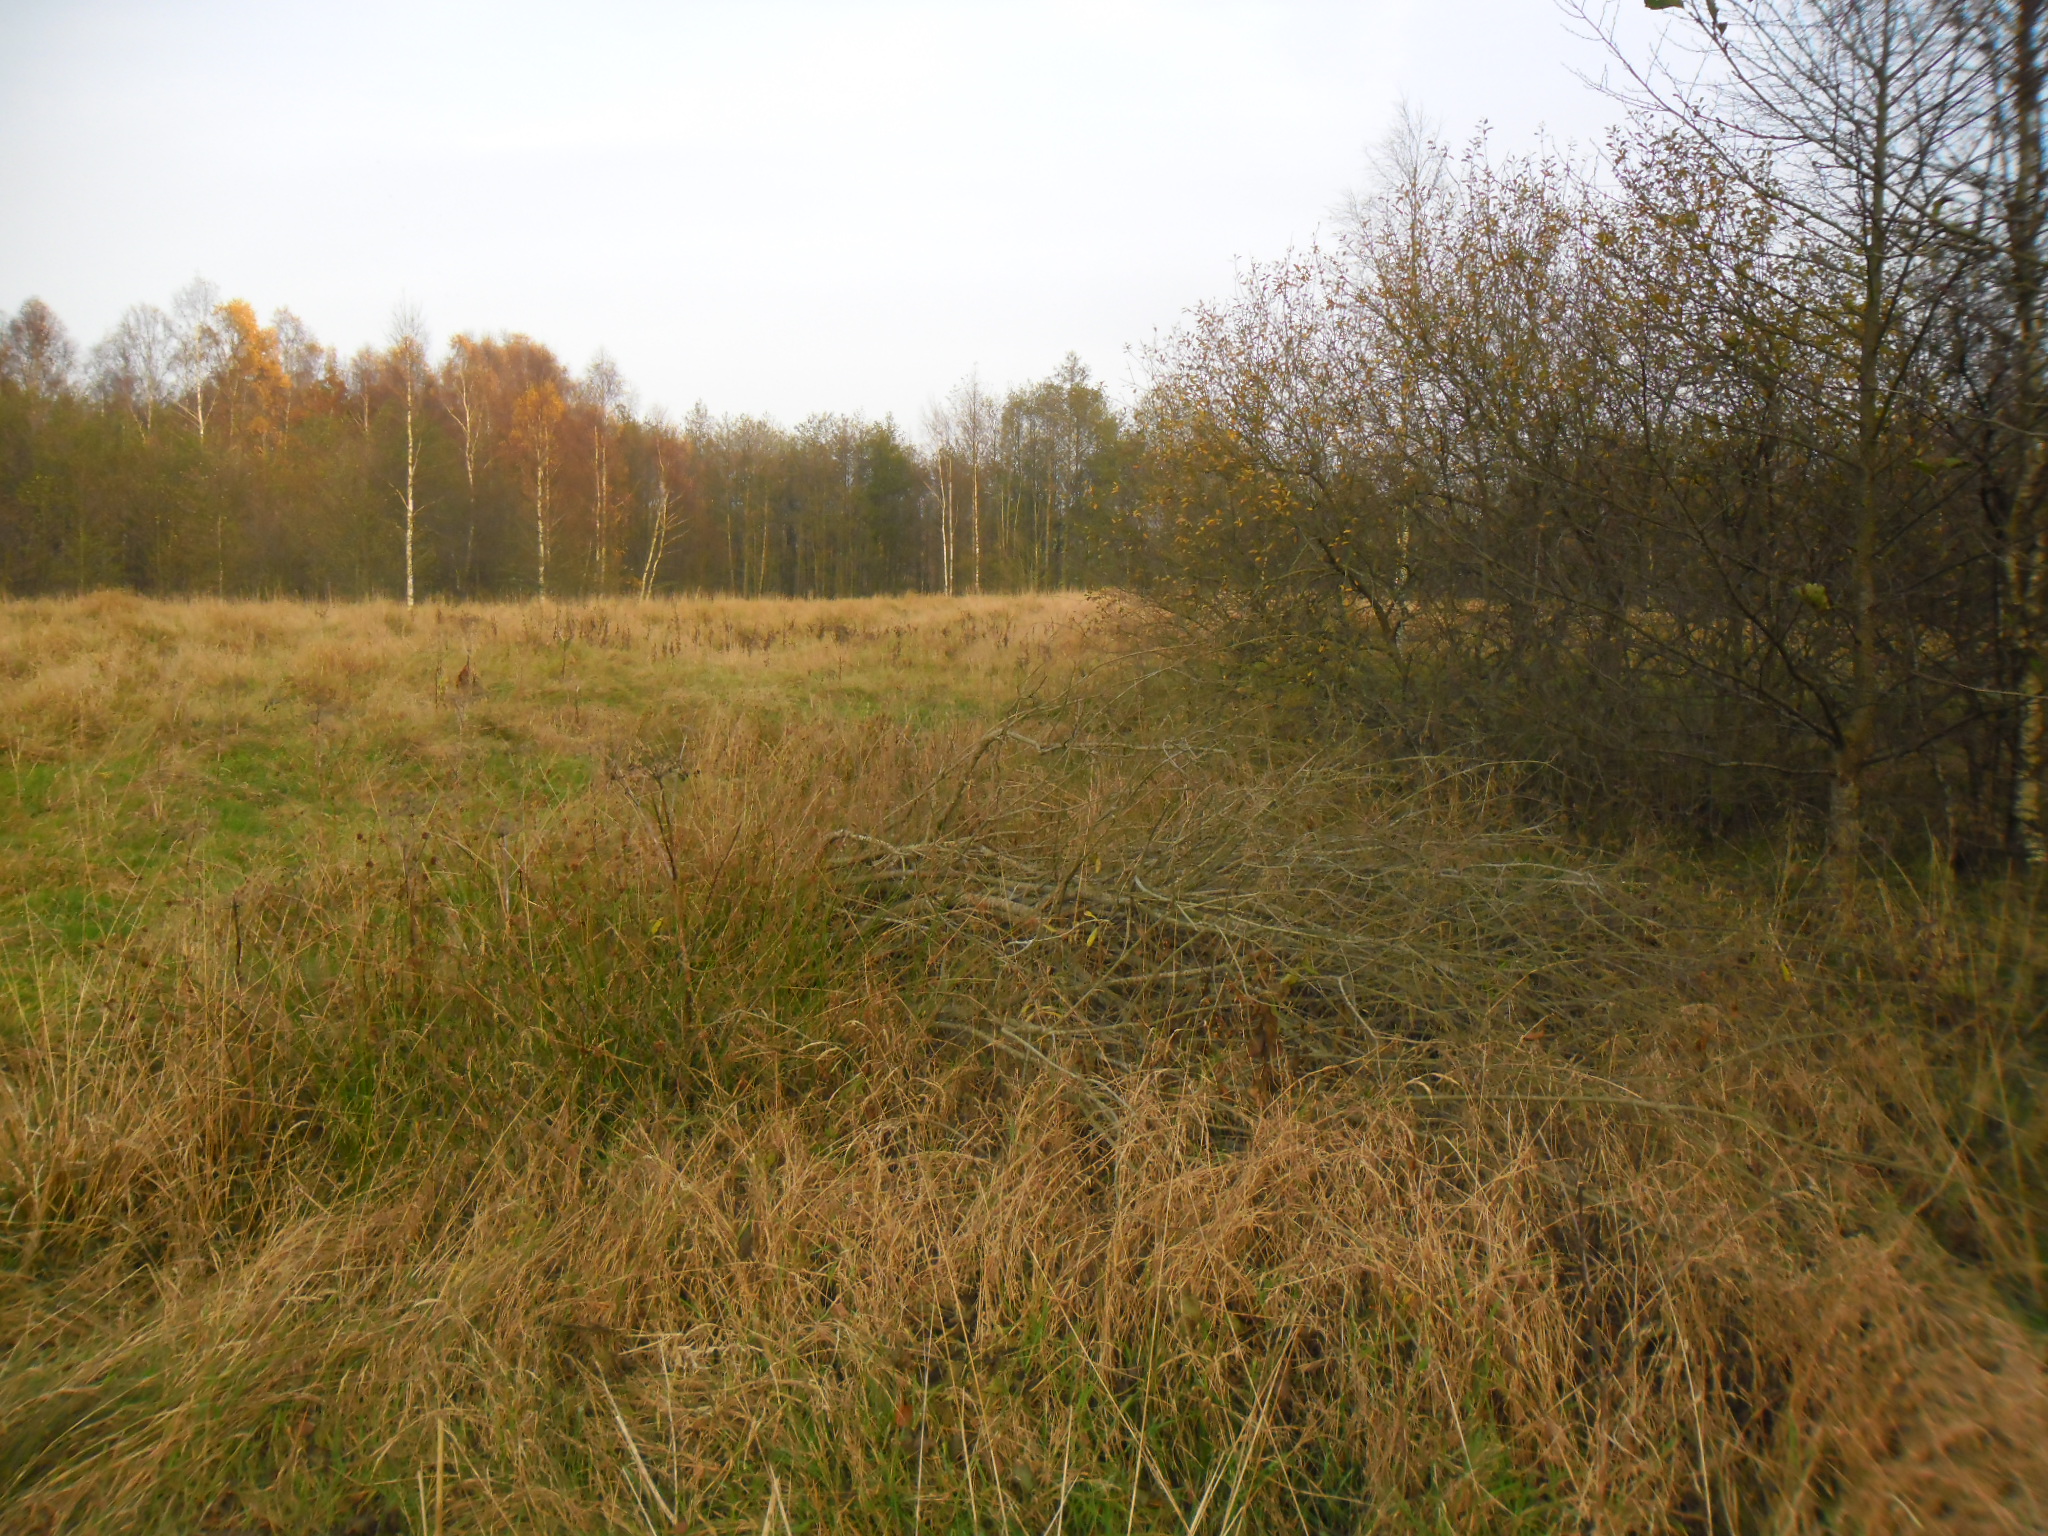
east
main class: Grassland
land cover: Grassland without tree/shrub cover
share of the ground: > 75 %
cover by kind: herbaceous plants 100 %
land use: Semi-natural and natural areas not in use
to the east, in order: Grassland without tree/shrub cover; Spruce dominated mixed woodland; Spontaneously vegetated surfaces; Pine dominated coniferous woodland; Broadleaved woodland; Inland marshes; Spruce dominated mixed woodland
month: November
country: SE
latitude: 56.2580
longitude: 13.1128
